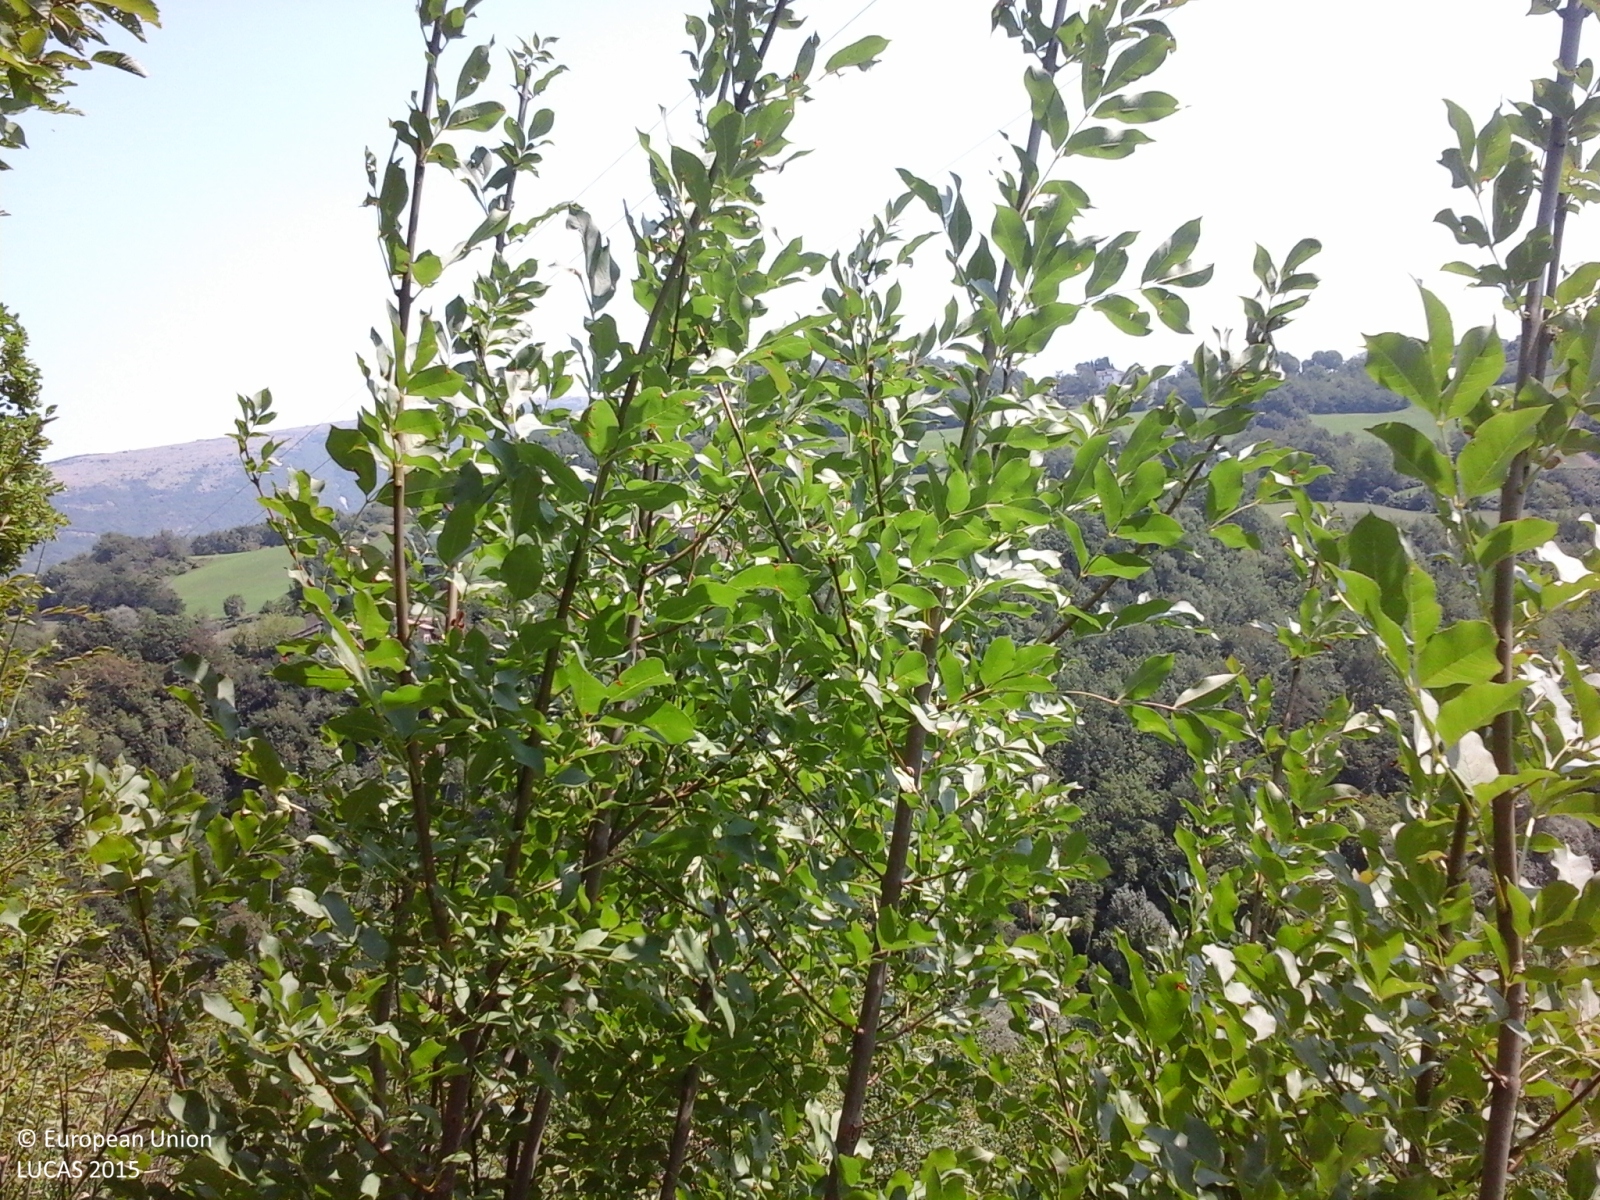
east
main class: Woodland
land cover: Broadleaved woodland
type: mesophytic deciduous forest
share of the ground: > 75 %
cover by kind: broadleaved forest trees 100 %
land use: Forestry
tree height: > 5 m
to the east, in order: Broadleaved woodland; Electric lines; Broadleaved woodland; Shrubland without tree cover; Broadleaved woodland; Tracks; Broadleaved woodland; Spontaneously vegetated surfaces; Broadleaved woodland; Ditches and canals; Broadleaved woodland
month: August
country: IT
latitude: 43.0757
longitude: 13.1232
